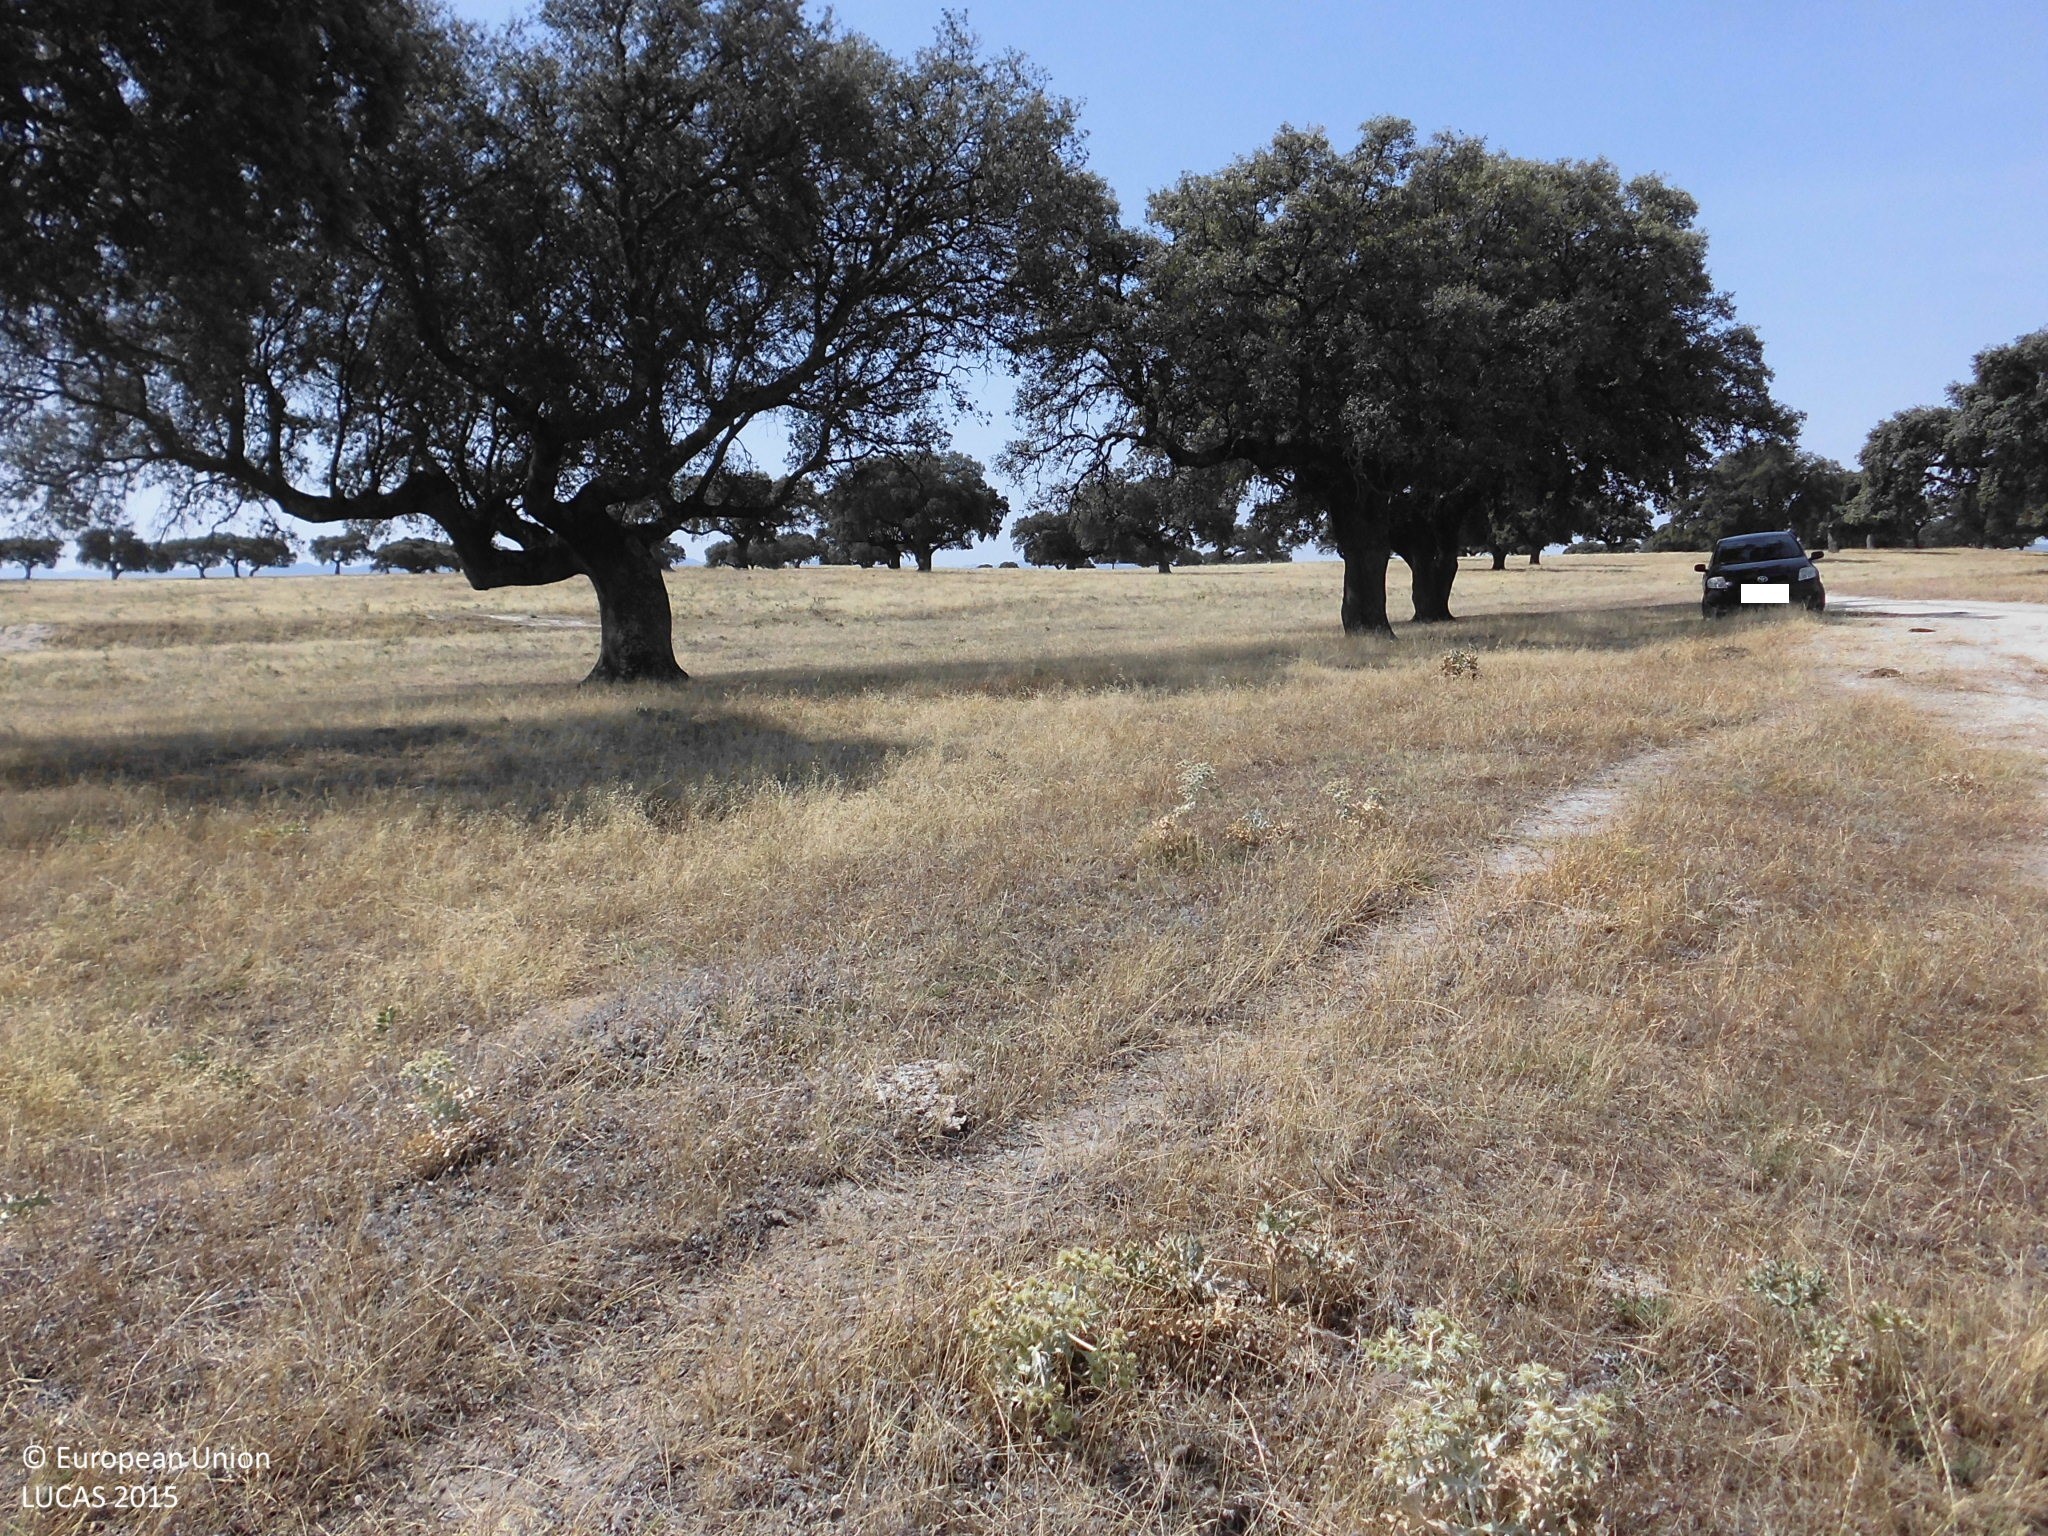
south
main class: Woodland
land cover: Broadleaved woodland
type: broadleaved evergreen forest
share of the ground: 10 - 25 %
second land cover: Grassland without tree/shrub cover
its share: > 75 %
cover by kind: herbaceous plants 85 %, broadleaved forest trees 10 %, unconsolidated bare surface 5 %
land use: Forestry
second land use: Agriculture (excluding fallow land and kitchen gardens)
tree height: > 5 m
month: July
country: ES
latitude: 39.9047
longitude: -5.4150
